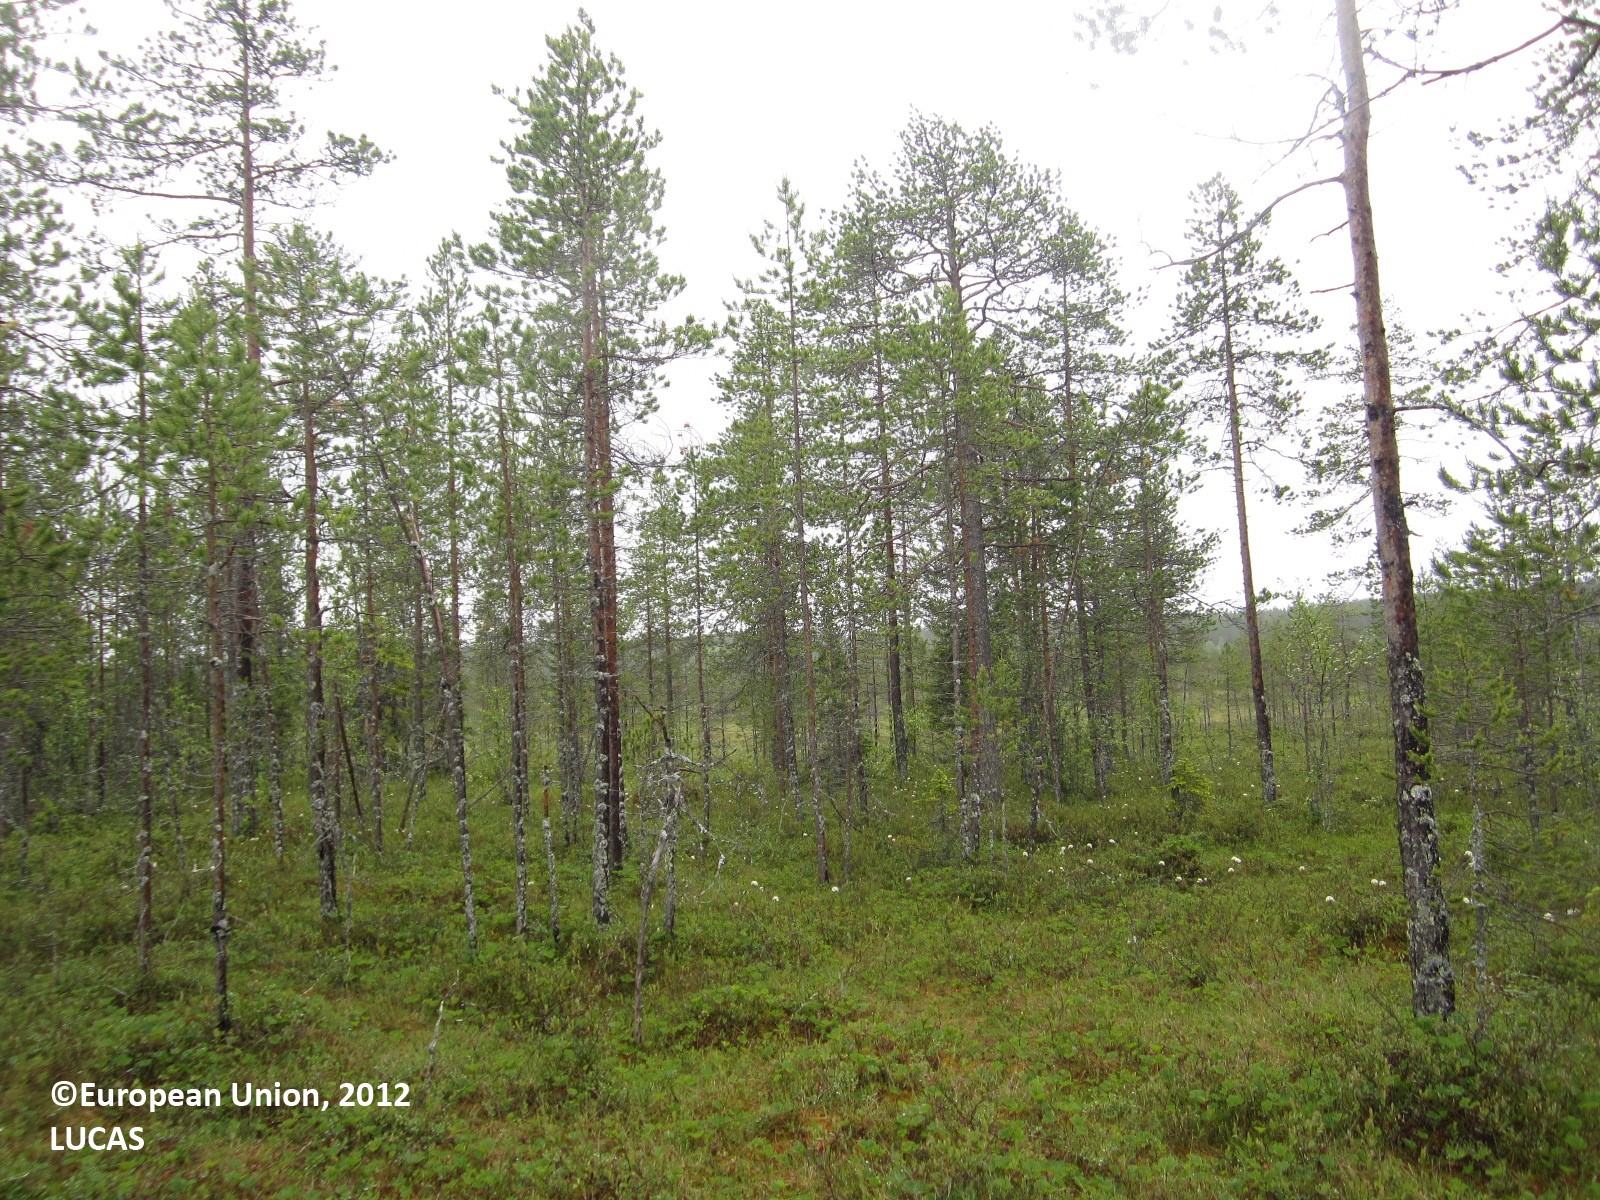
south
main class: Woodland
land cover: Pine dominated coniferous woodland
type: boreal forest
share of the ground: 10 - 25 %
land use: Forestry
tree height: > 5 m
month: June
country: FI
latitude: 64.4987
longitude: 29.9458
